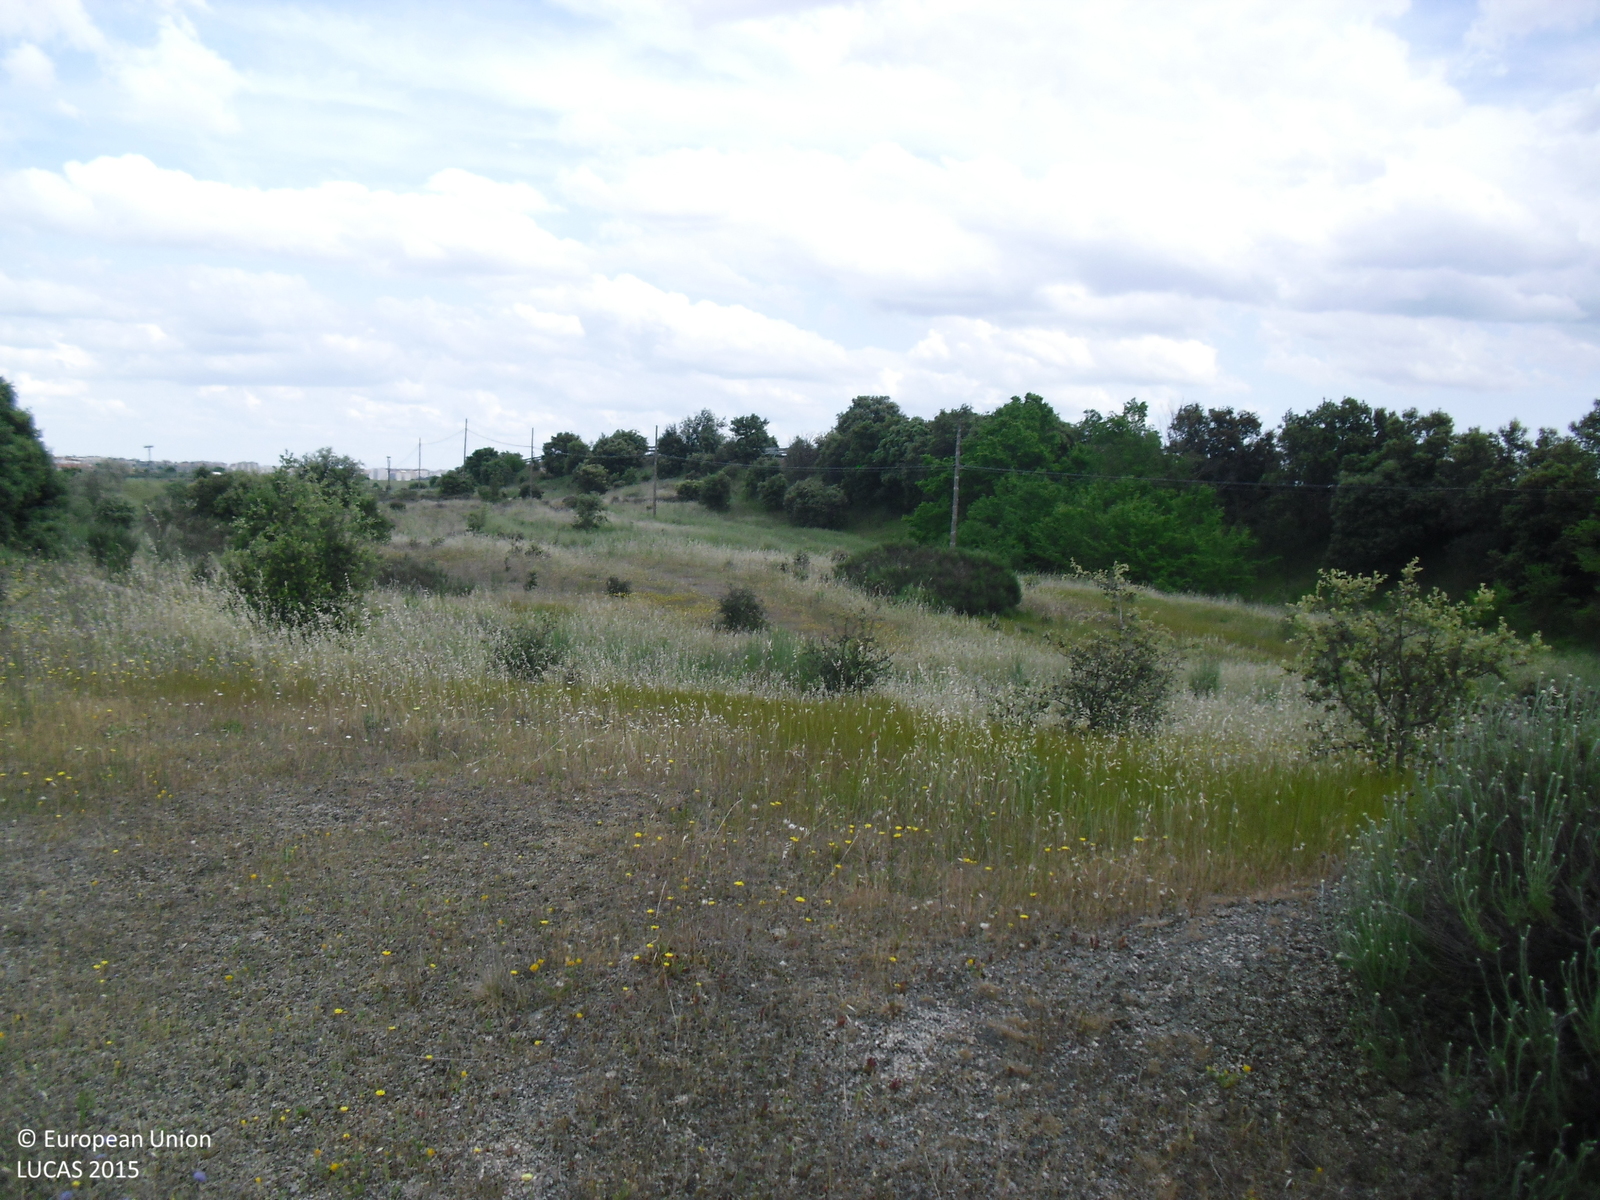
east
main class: Shrubland
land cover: Shrubland with sparse tree cover
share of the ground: > 75 %
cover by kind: herbaceous plants 75 %, shrubs 20 %, broadleaved forest trees 5 %
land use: Semi-natural and natural areas not in use
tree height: < 5 m
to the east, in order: Shrubland with sparse tree cover; Grassland with sparse tree/shrub cover; Electric lines; Managed hedges; Fences; Paved roads, cycling and walking lanes
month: April
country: ES
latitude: 39.4584
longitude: -6.4446
